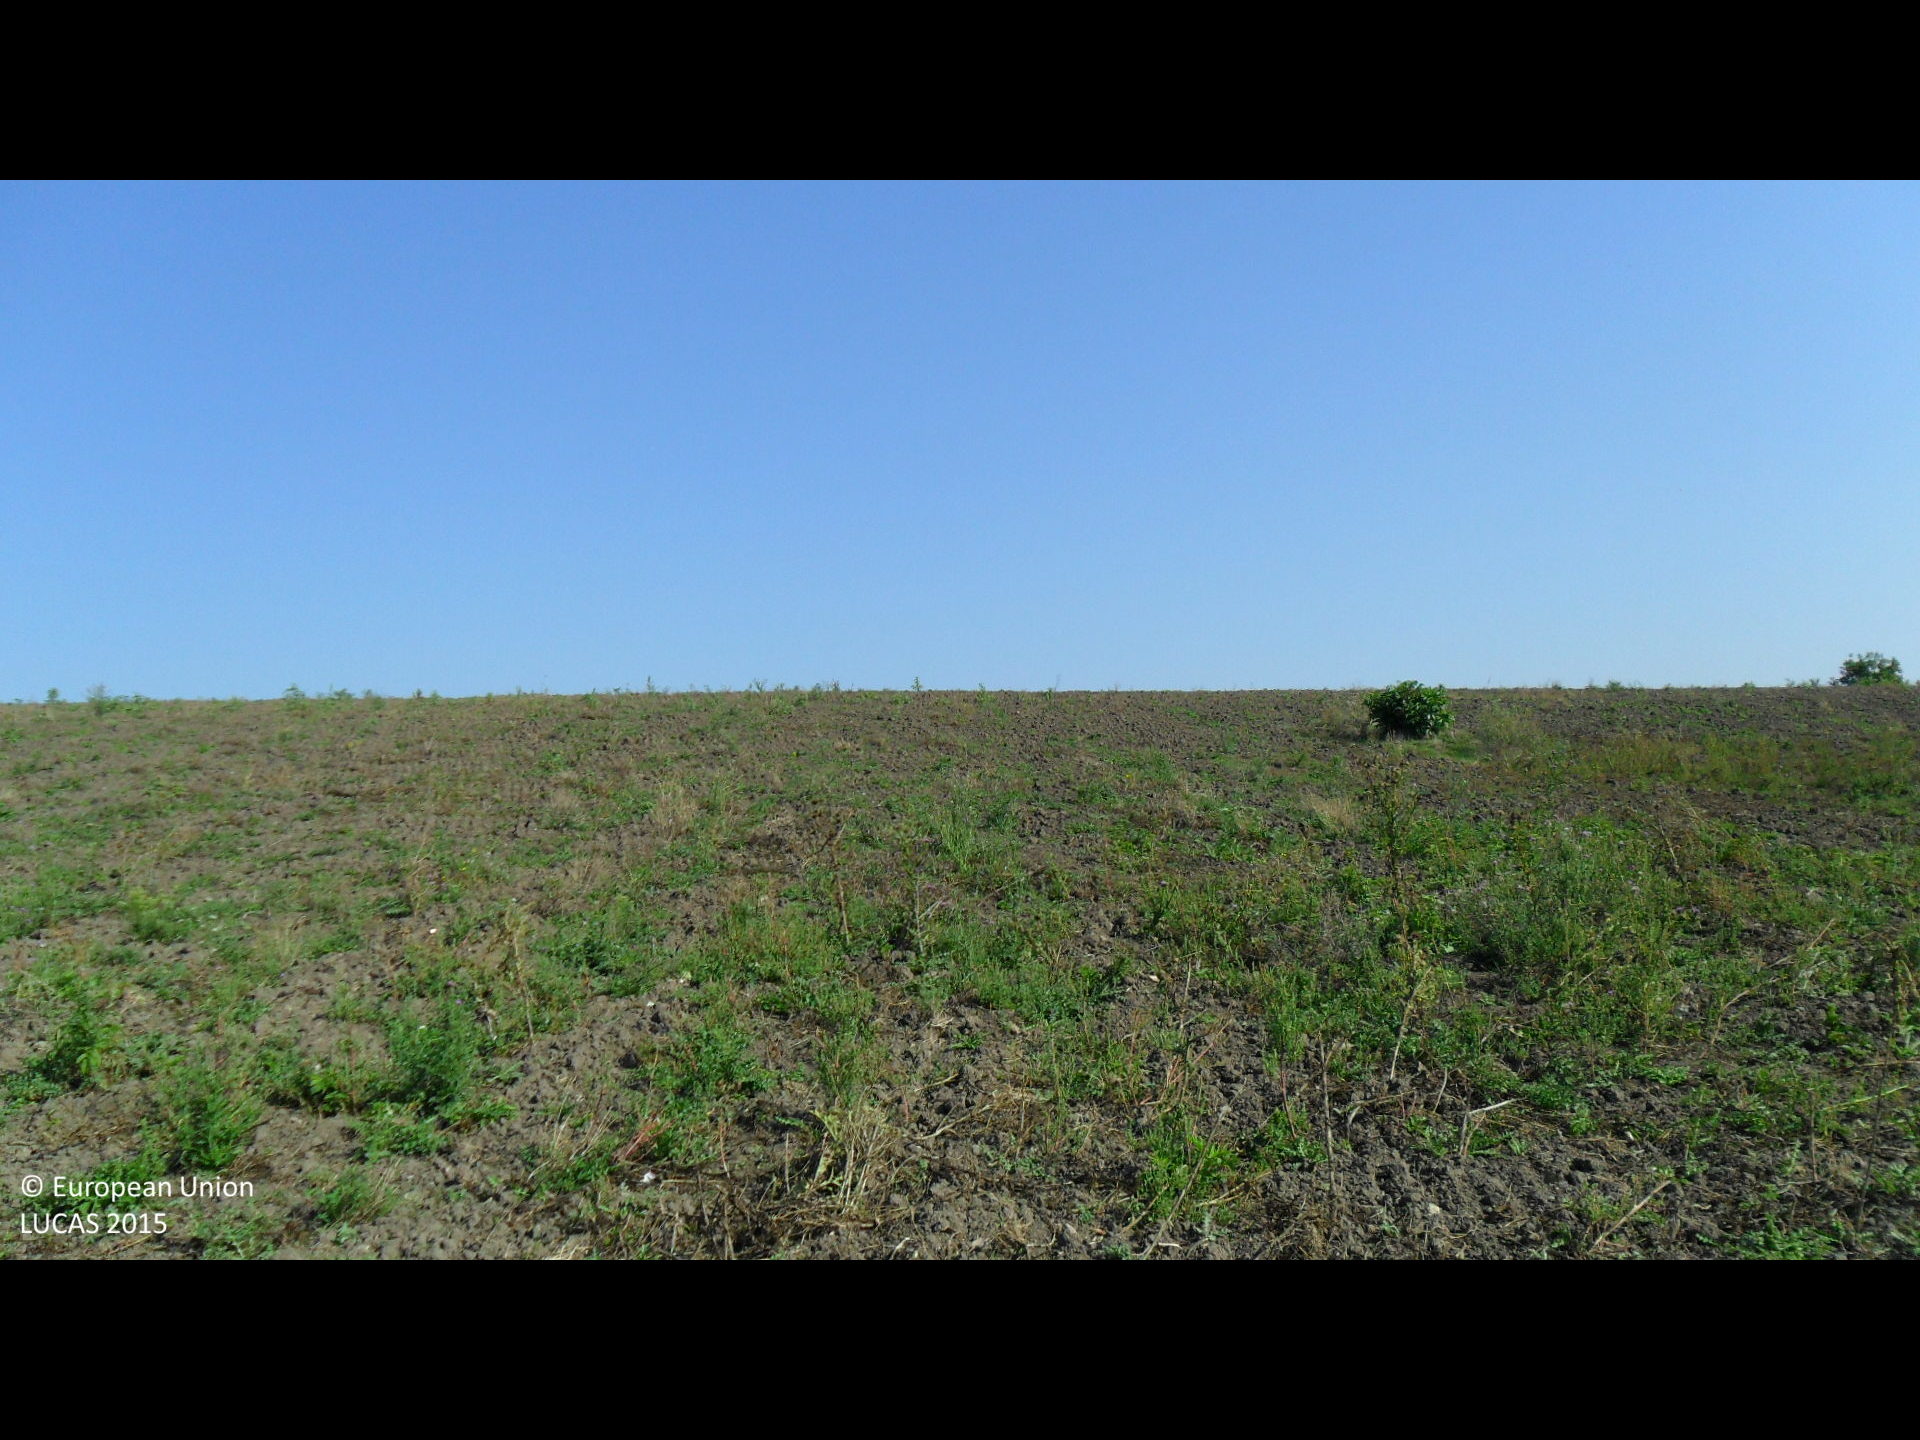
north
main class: Grassland
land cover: Spontaneously vegetated surfaces
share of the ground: 50 - 75 %
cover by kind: herbaceous plants 75 %, consolidated bare surface 25 %
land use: Fallow land
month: August
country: BG
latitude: 43.3321
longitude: 26.4935
